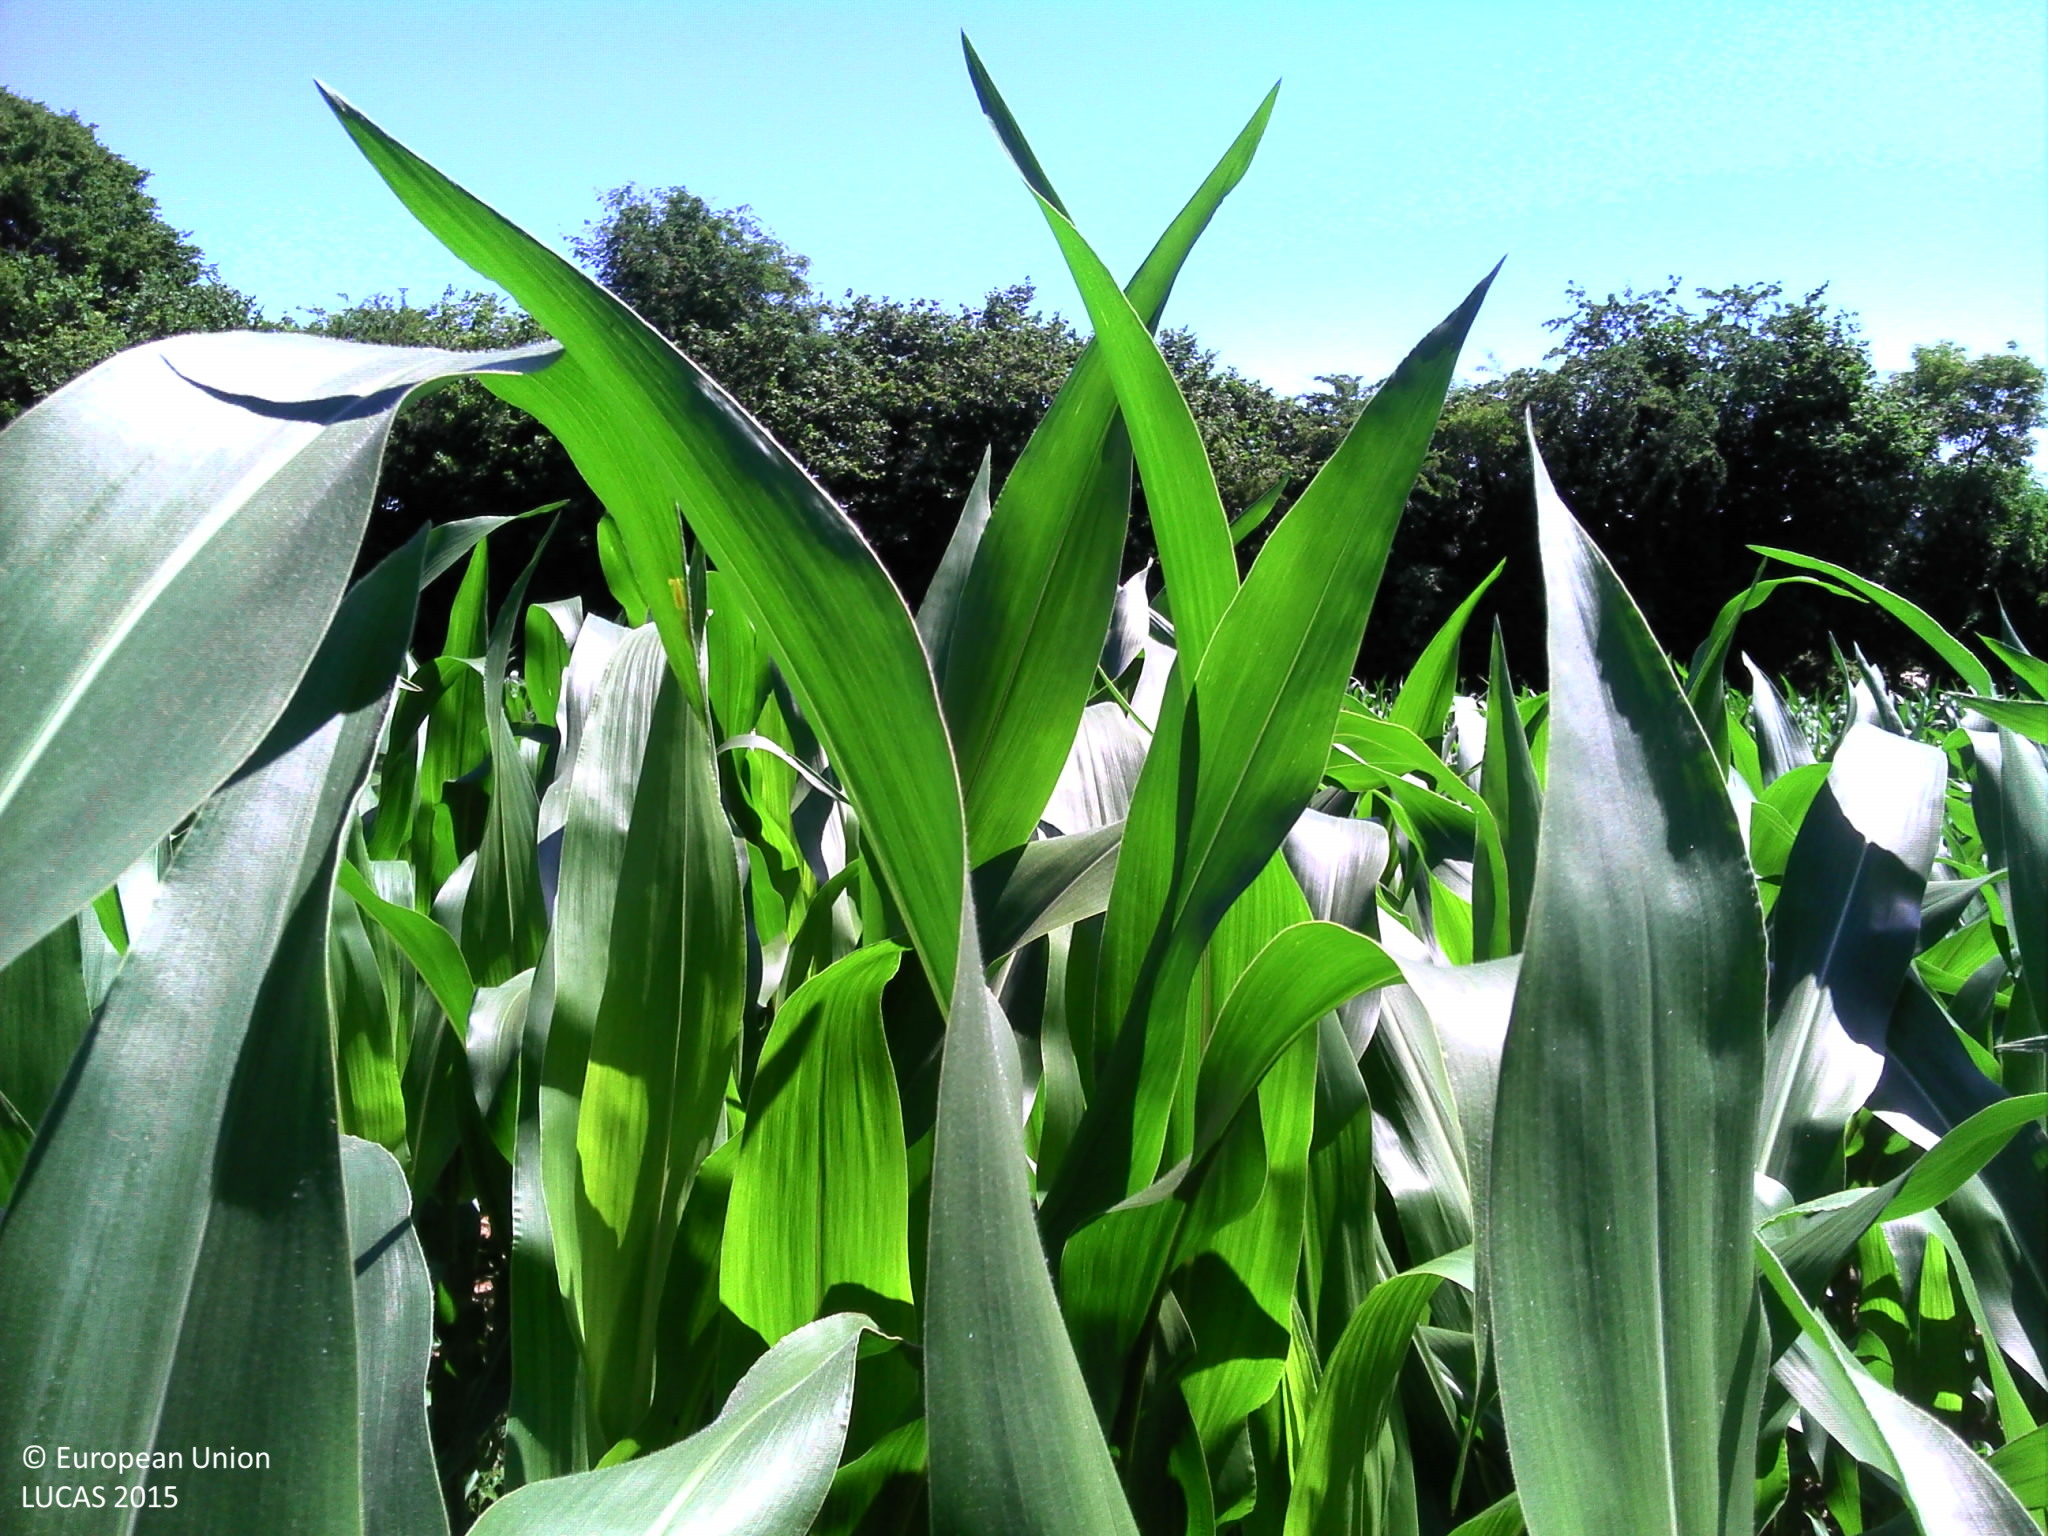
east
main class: Cropland
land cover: Maize
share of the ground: > 75 %
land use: Agriculture (excluding fallow land and kitchen gardens)
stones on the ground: < 10 %
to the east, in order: Maize; Fences; Abandoned hedges; Grassland without tree/shrub cover; Artificial constructions in urban areas
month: July
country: BE
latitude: 50.1160
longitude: 5.5652
